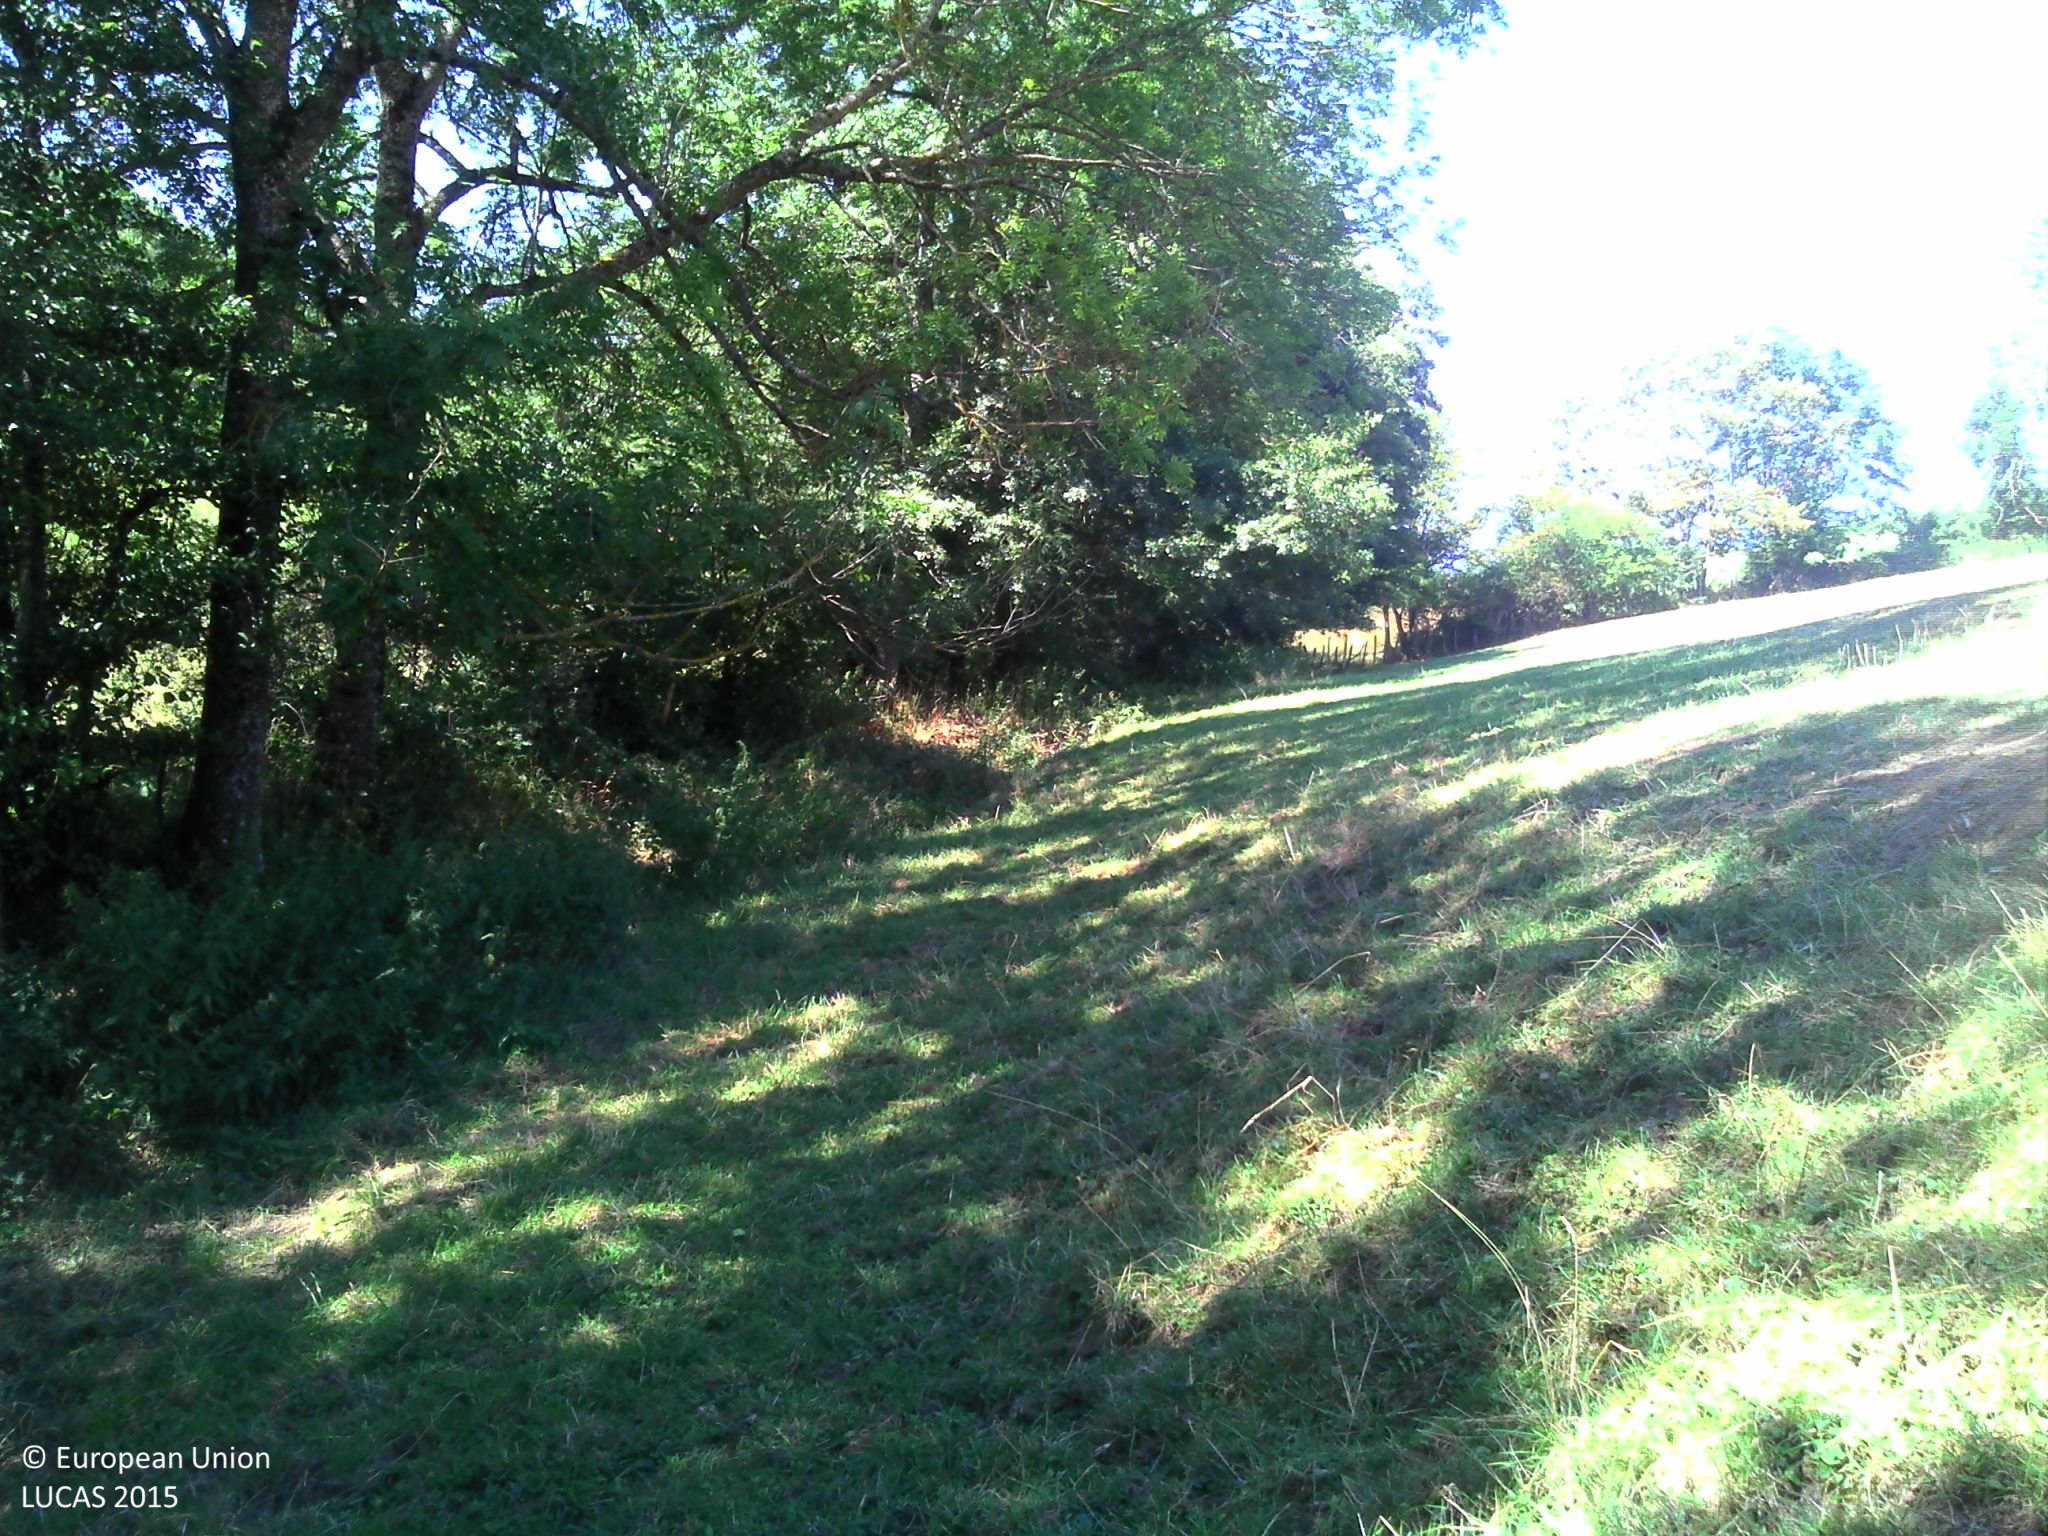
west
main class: Grassland
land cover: Grassland without tree/shrub cover
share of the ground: > 75 %
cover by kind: herbaceous plants 100 %
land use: Agriculture (excluding fallow land and kitchen gardens)
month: August
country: FR
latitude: 45.6885
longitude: 4.5461
